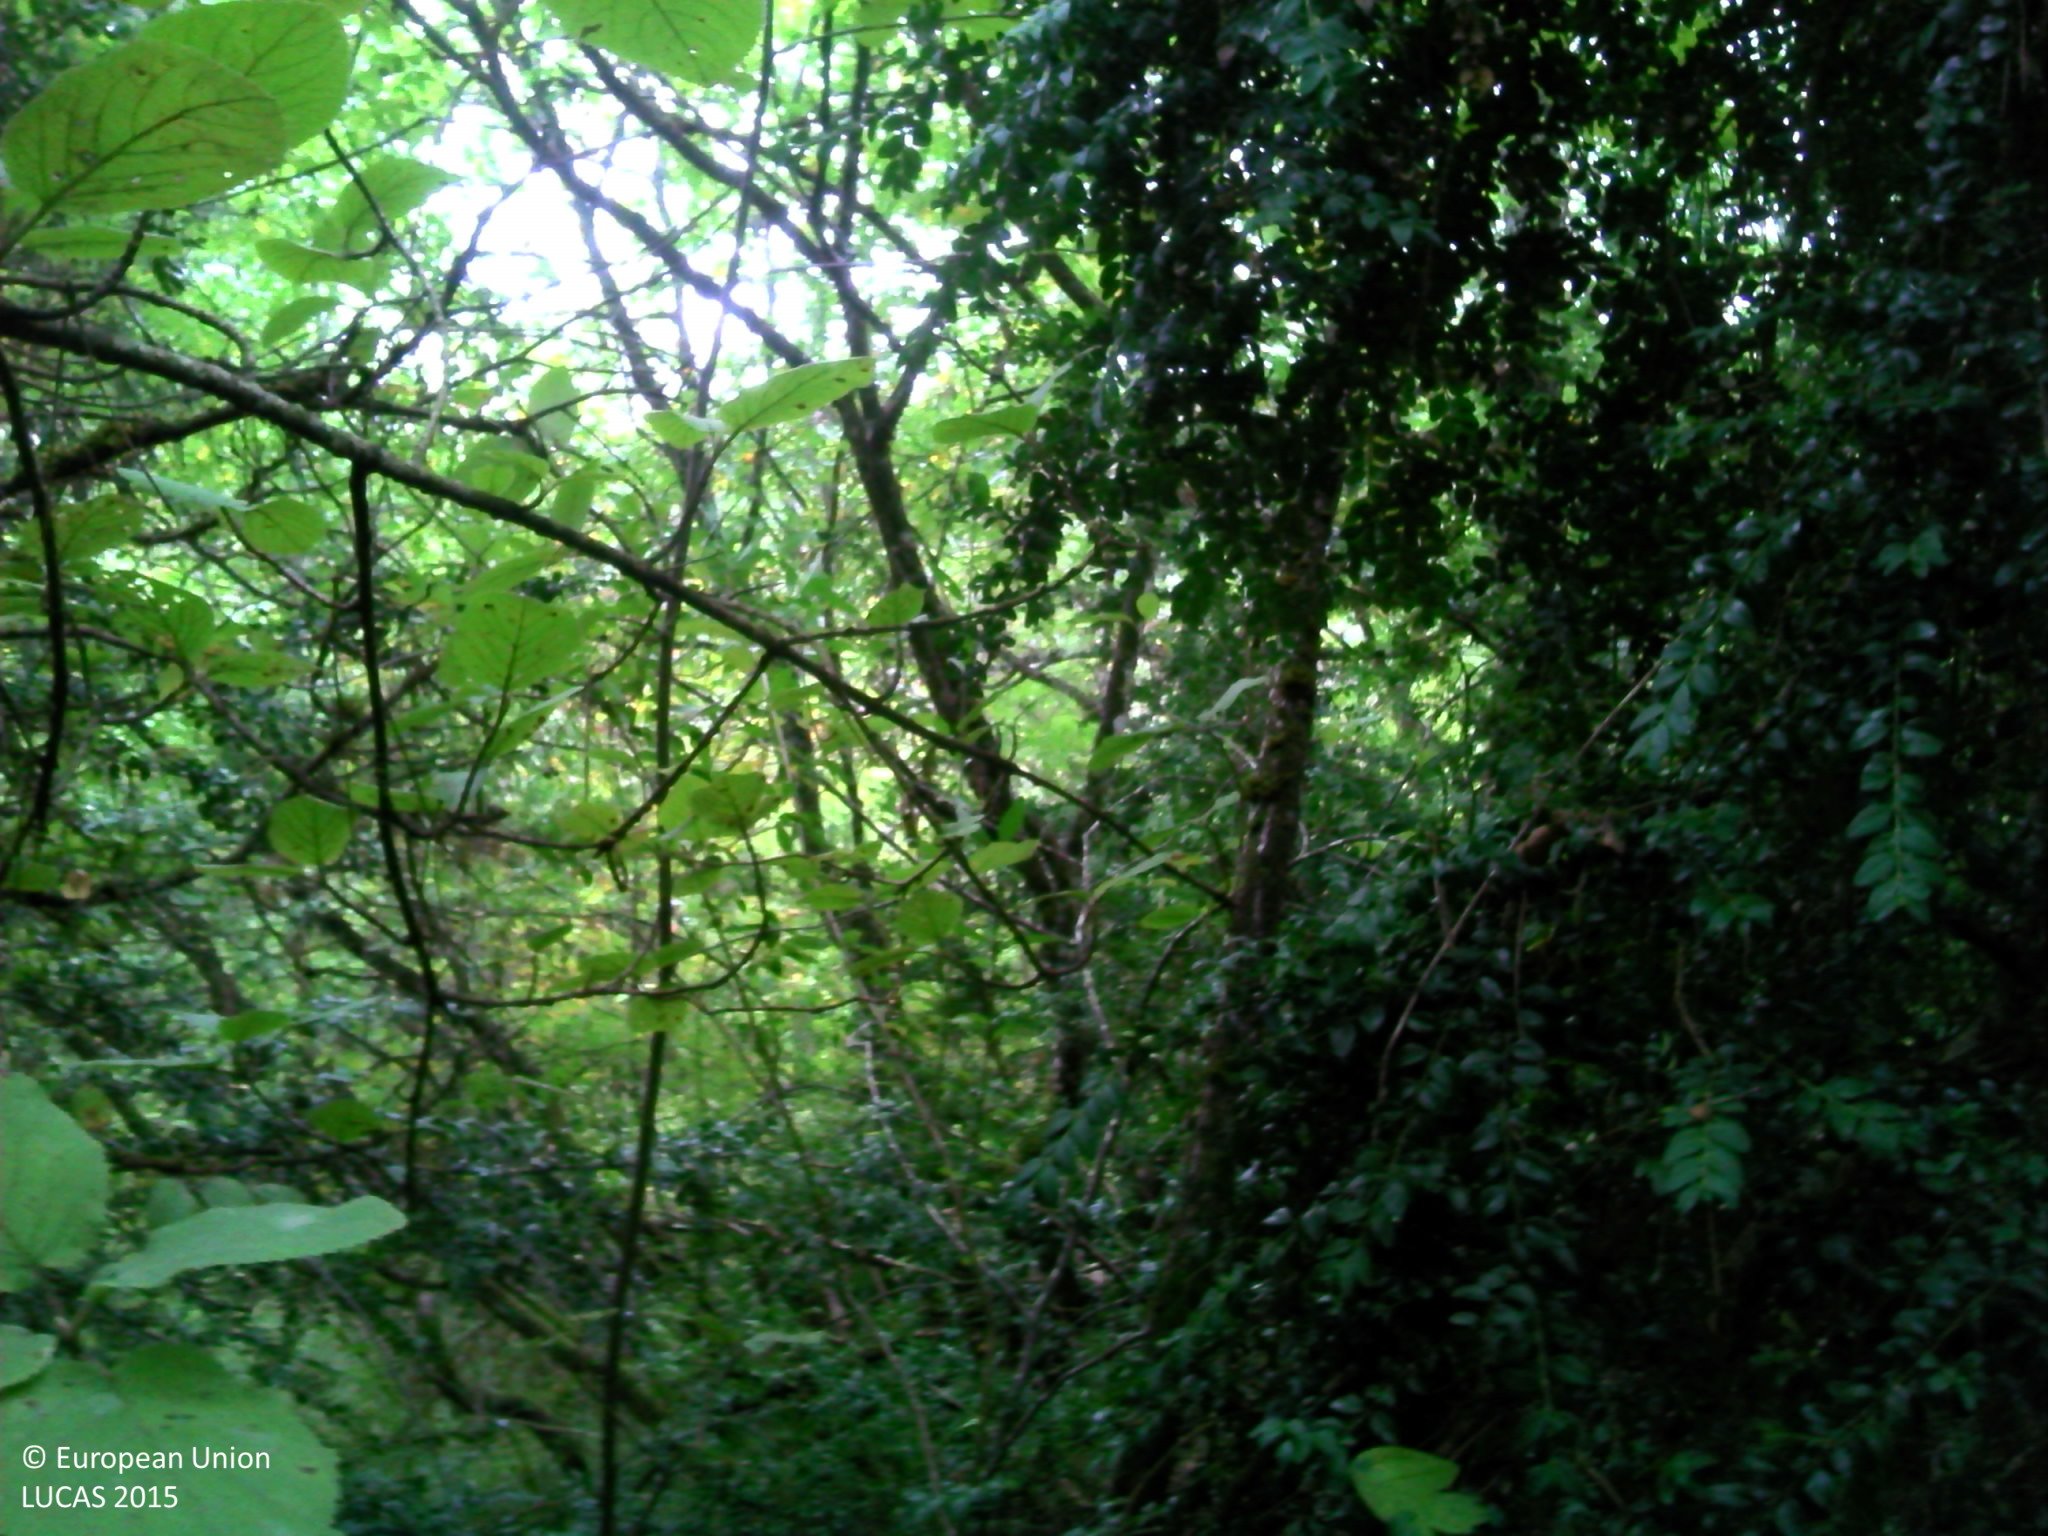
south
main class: Woodland
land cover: Pine dominated mixed woodland
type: hemiboreal forest and nemoral coniferous forest and mixed broadleaved-coniferous forest
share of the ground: > 75 %
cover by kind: coniferous forest trees 70 %, broadleaved forest trees 25 %, shrubs 5 %
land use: Forestry
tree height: > 5 m
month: September
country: FR
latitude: 47.0151
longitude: 4.7255
